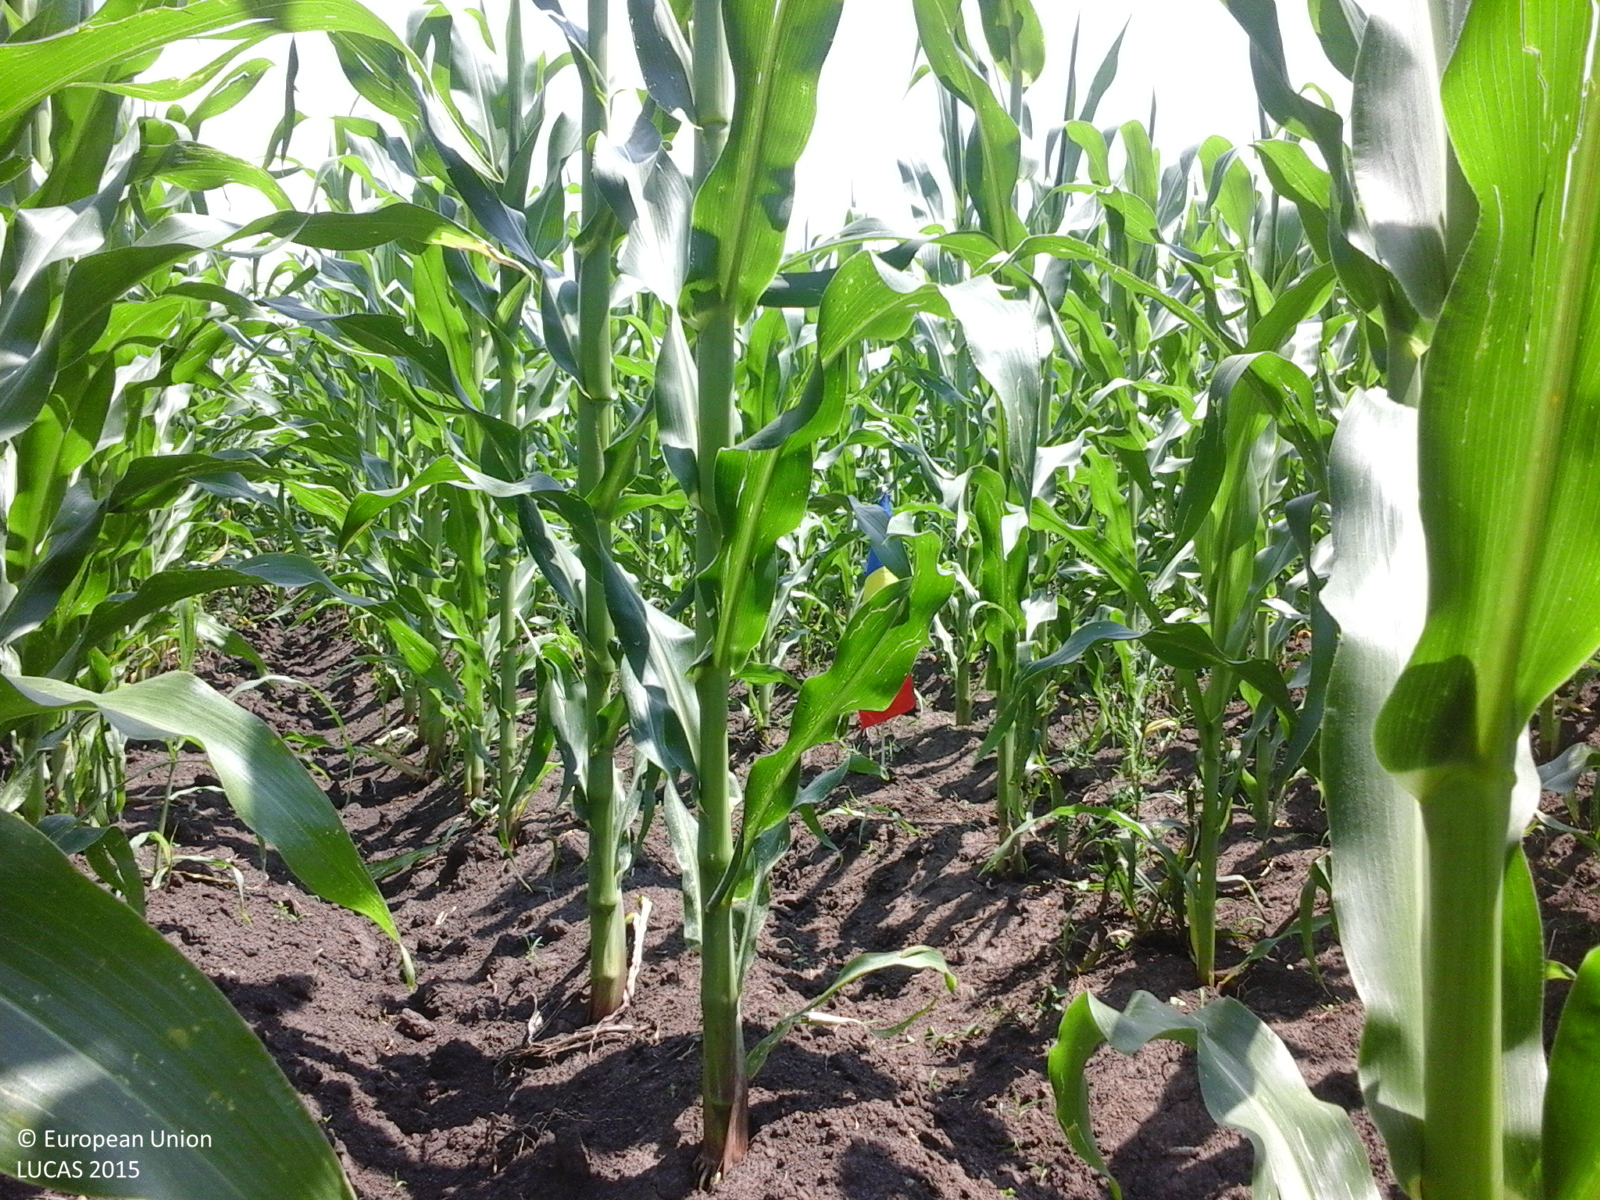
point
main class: Cropland
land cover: Maize
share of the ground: > 75 %
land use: Agriculture (excluding fallow land and kitchen gardens)
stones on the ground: < 10 %
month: July
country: RO
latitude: 43.9867
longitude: 25.4844
